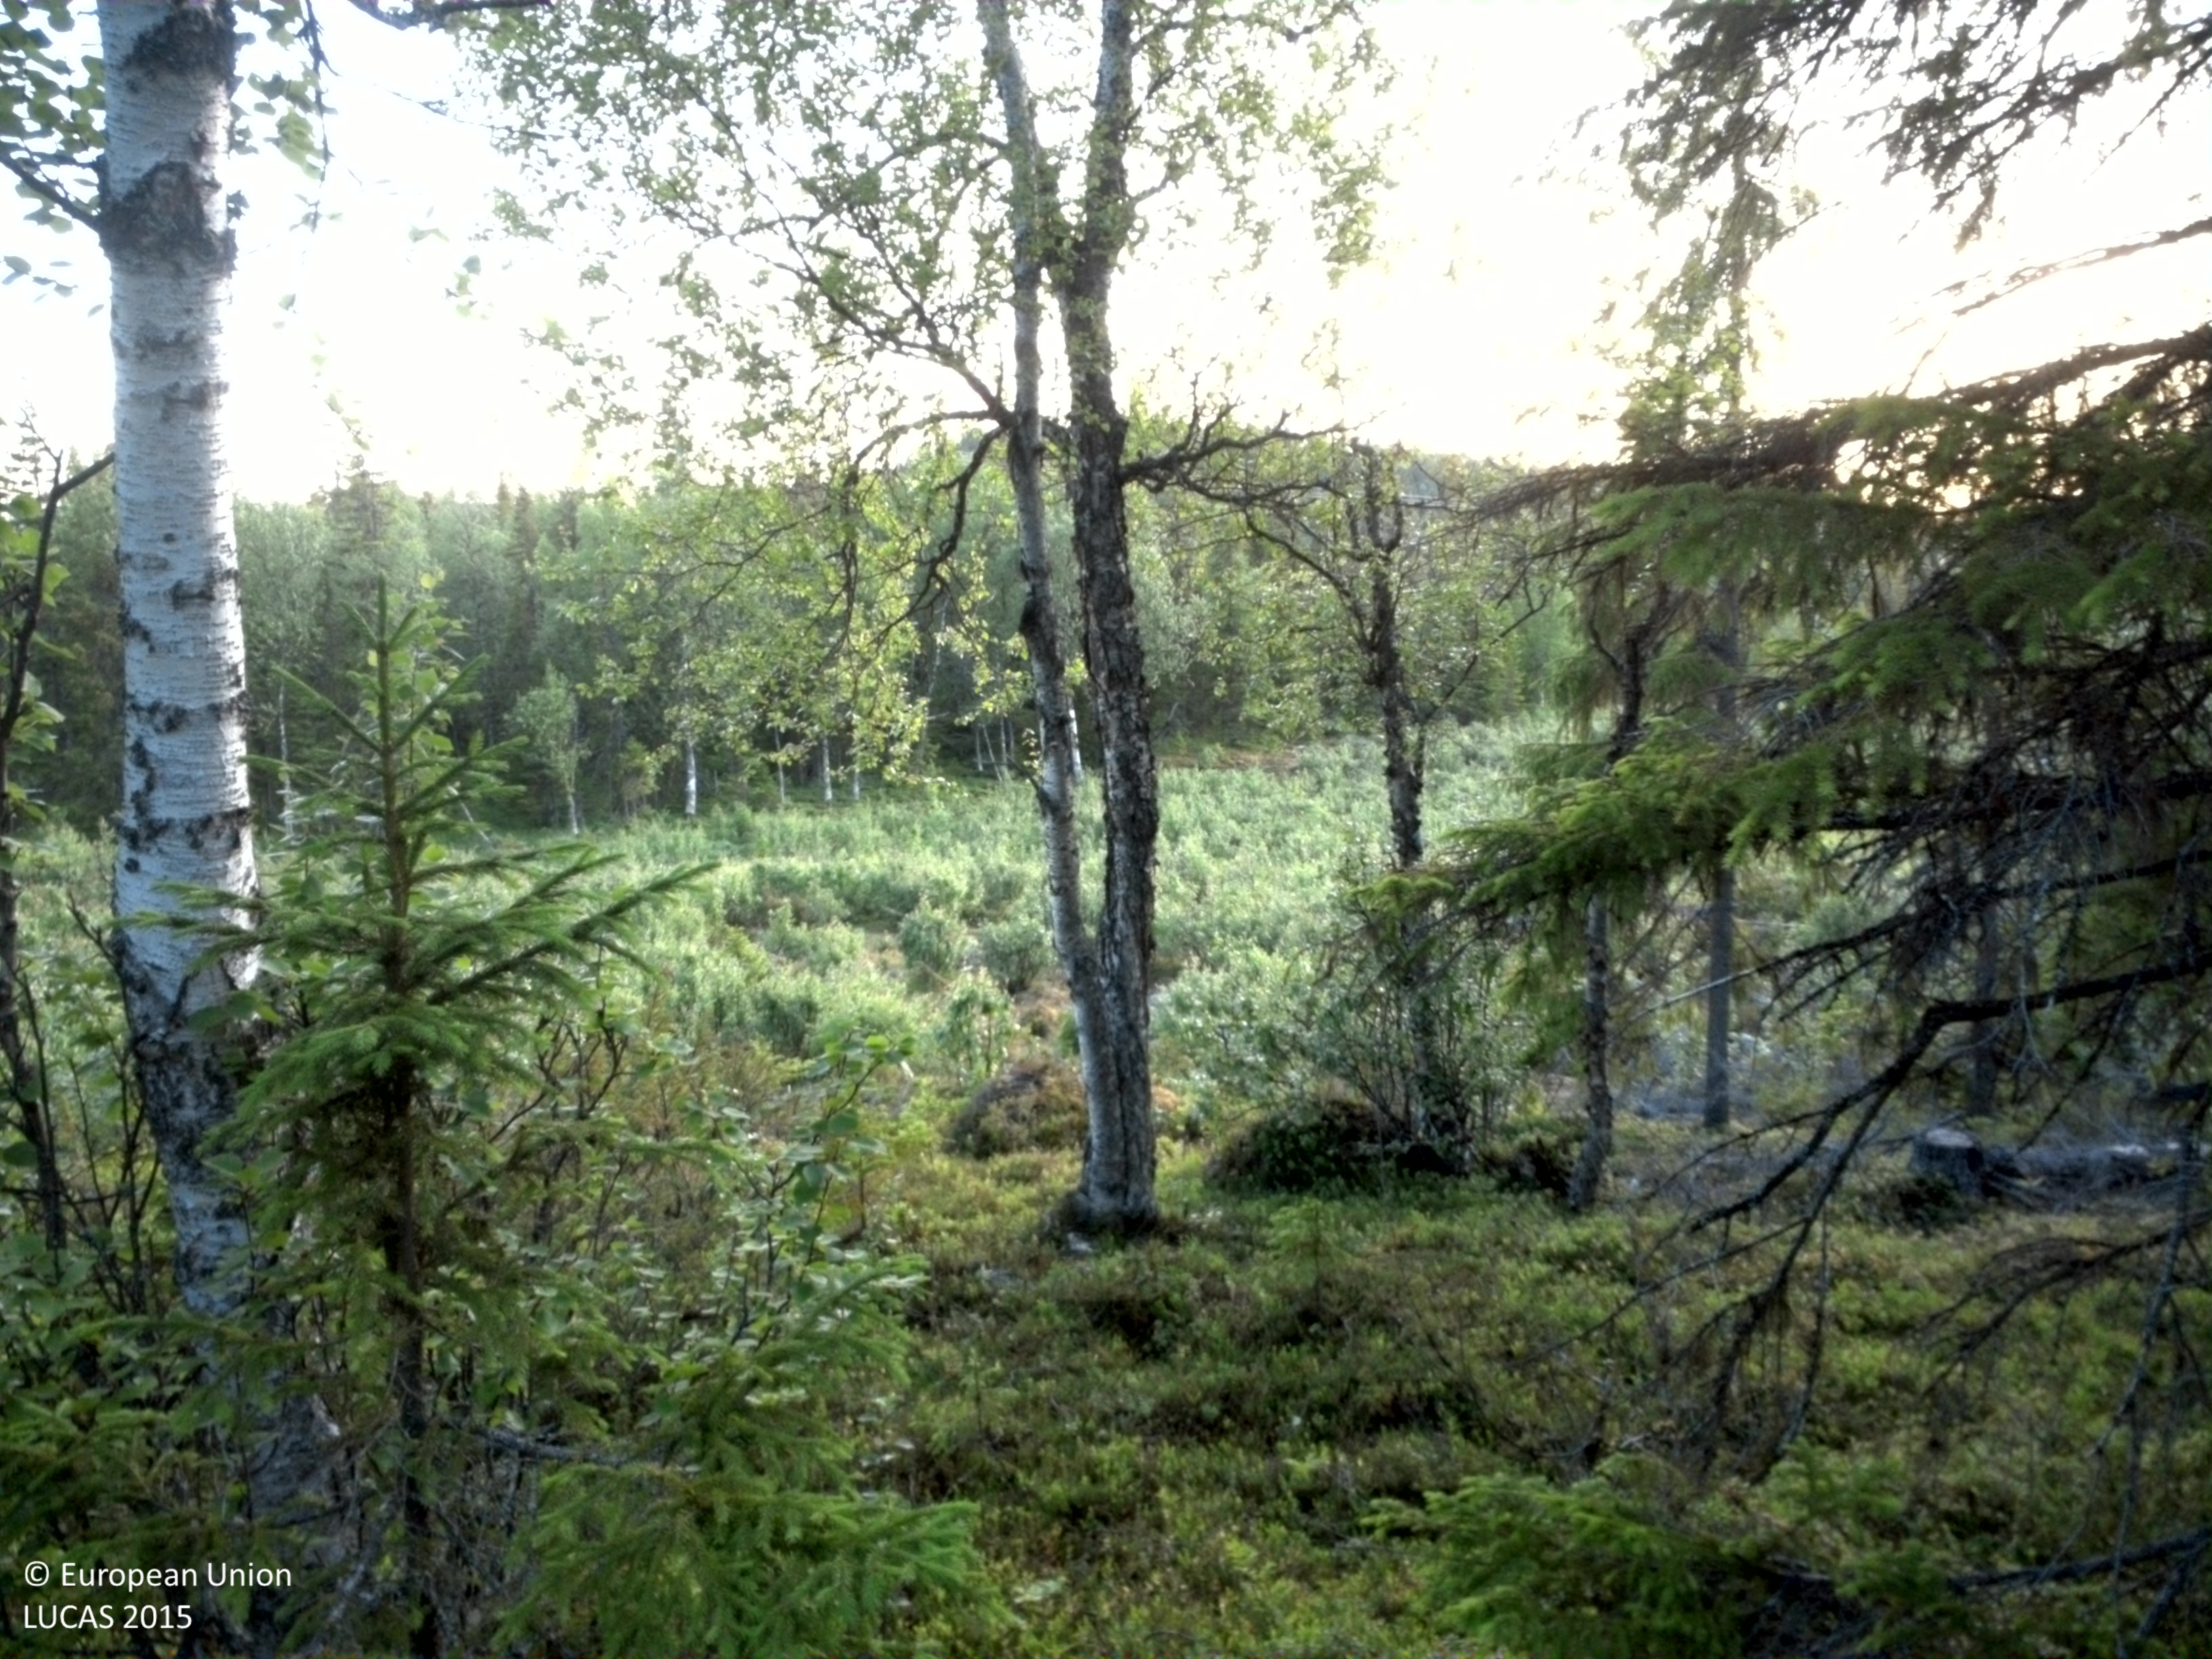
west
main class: Woodland
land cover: Spruce dominated mixed woodland
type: boreal forest
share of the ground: 25 - 50 %
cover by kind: shrubs 45 %, coniferous forest trees 25 %, broadleaved forest trees 20 %, lichens and mosses 10 %
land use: Forestry
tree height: > 5 m
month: July
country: SE
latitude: 65.5365
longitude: 15.4400
